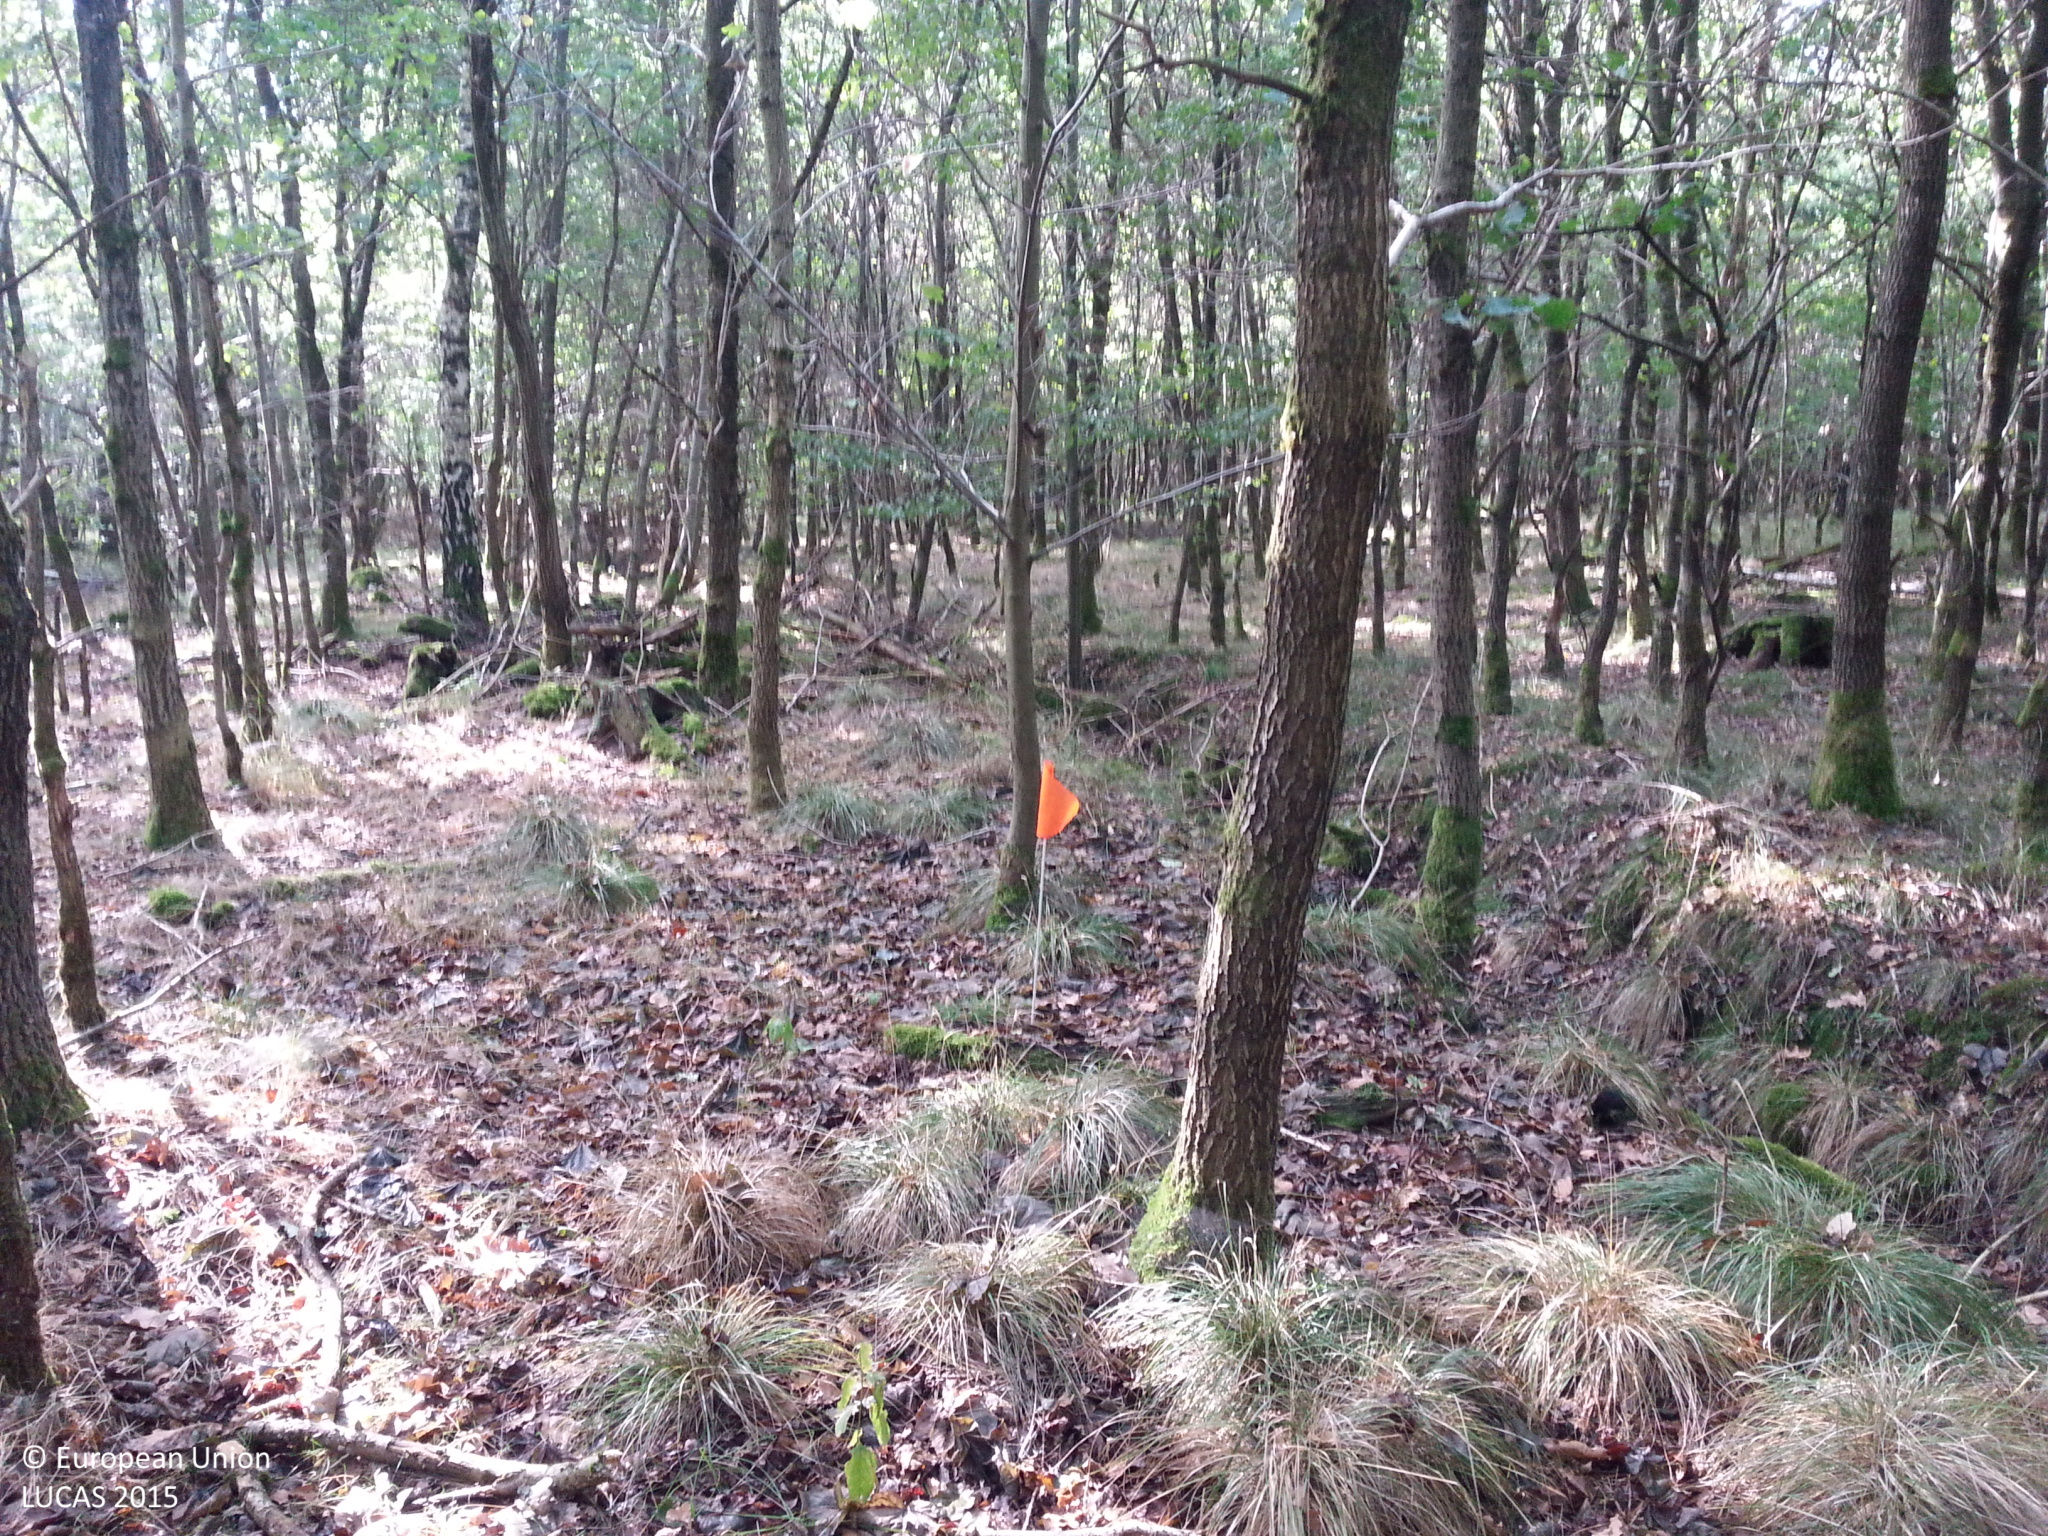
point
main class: Woodland
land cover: Broadleaved woodland
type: mesophytic deciduous forest
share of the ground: > 75 %
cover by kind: broadleaved forest trees 80 %, herbaceous plants 10 %, unconsolidated bare surface 10 %
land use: Forestry
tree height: > 5 m
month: September
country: DE
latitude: 49.6072
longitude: 9.4052
